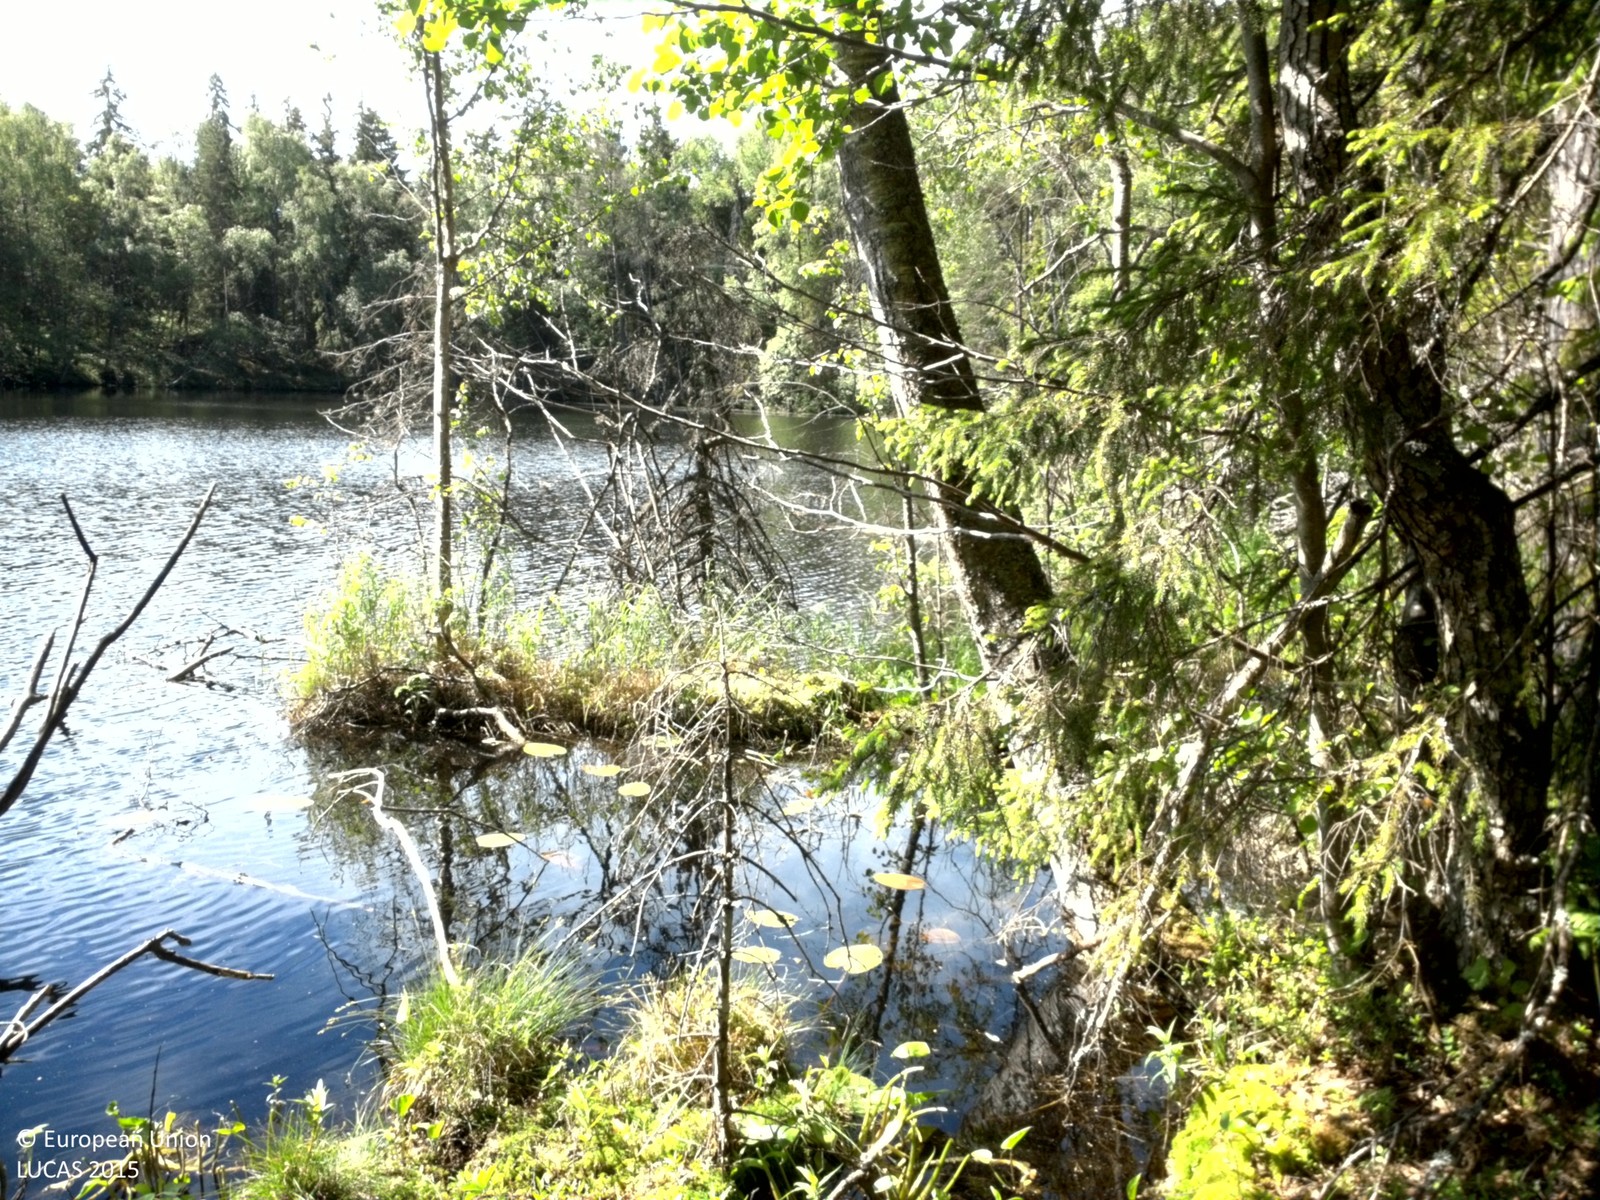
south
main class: Woodland
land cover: Spruce dominated mixed woodland
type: boreal forest
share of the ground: 25 - 50 %
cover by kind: herbaceous plants 40 %, coniferous forest trees 30 %, broadleaved forest trees 20 %, lichens and mosses 10 %
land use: Forestry
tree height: < 5 m
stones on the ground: < 10 %
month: June
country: SE
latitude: 58.6906
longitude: 16.1885
